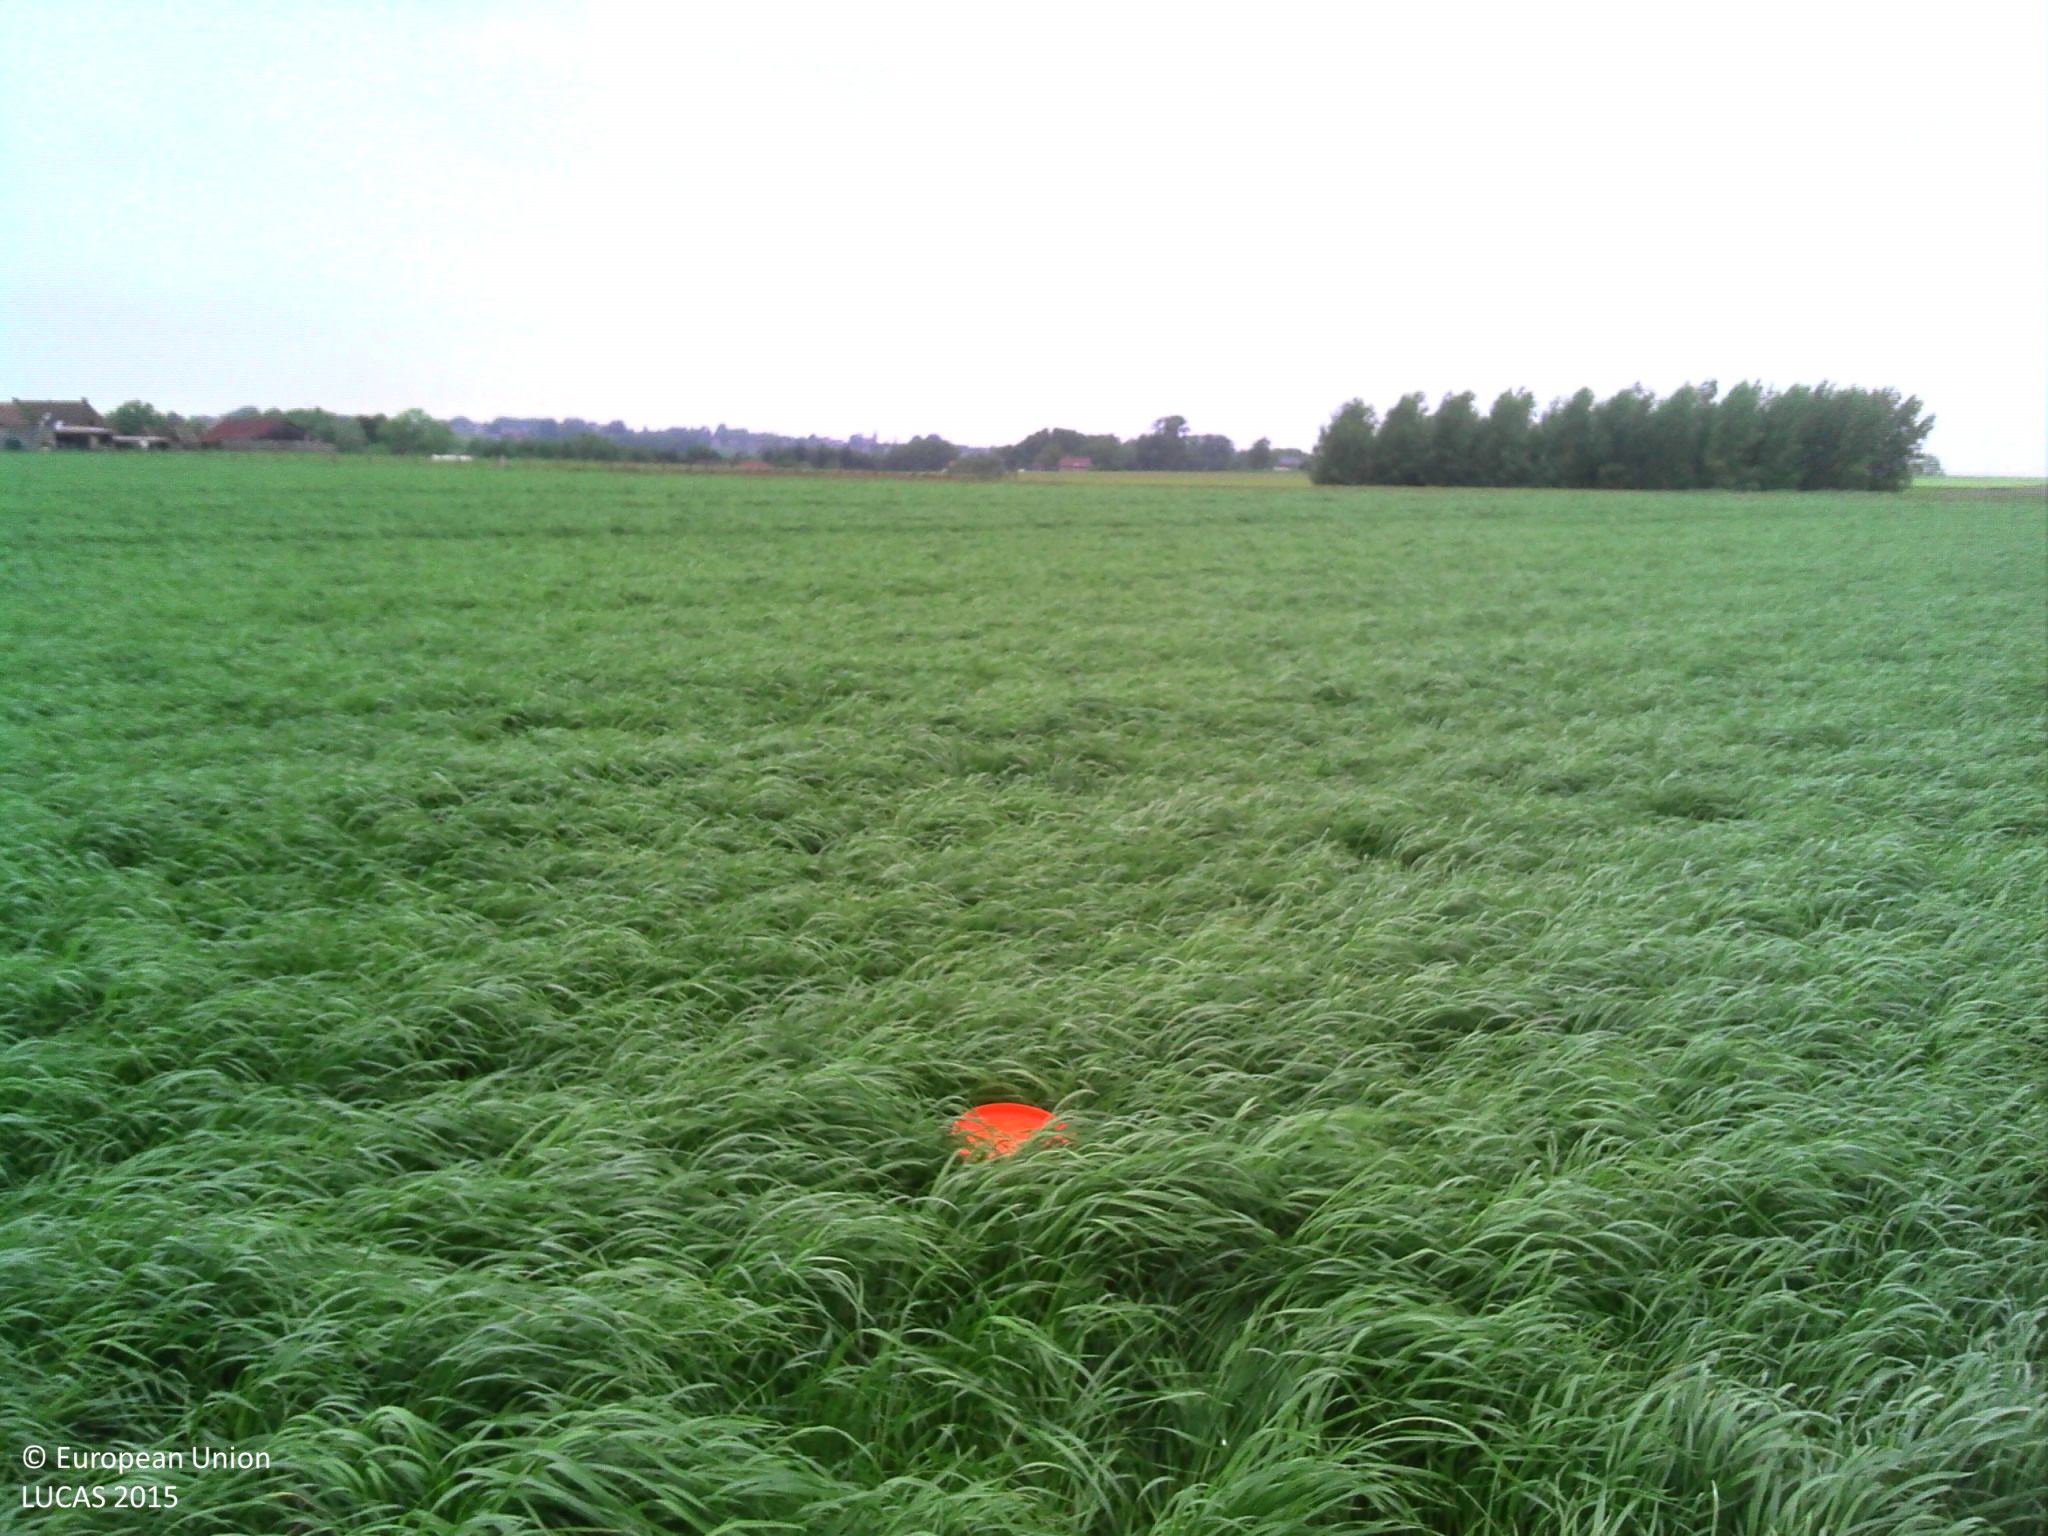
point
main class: Cropland
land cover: Temporary grasslands
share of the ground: > 75 %
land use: Agriculture (excluding fallow land and kitchen gardens)
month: June
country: BE
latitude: 50.8234
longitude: 3.7328
